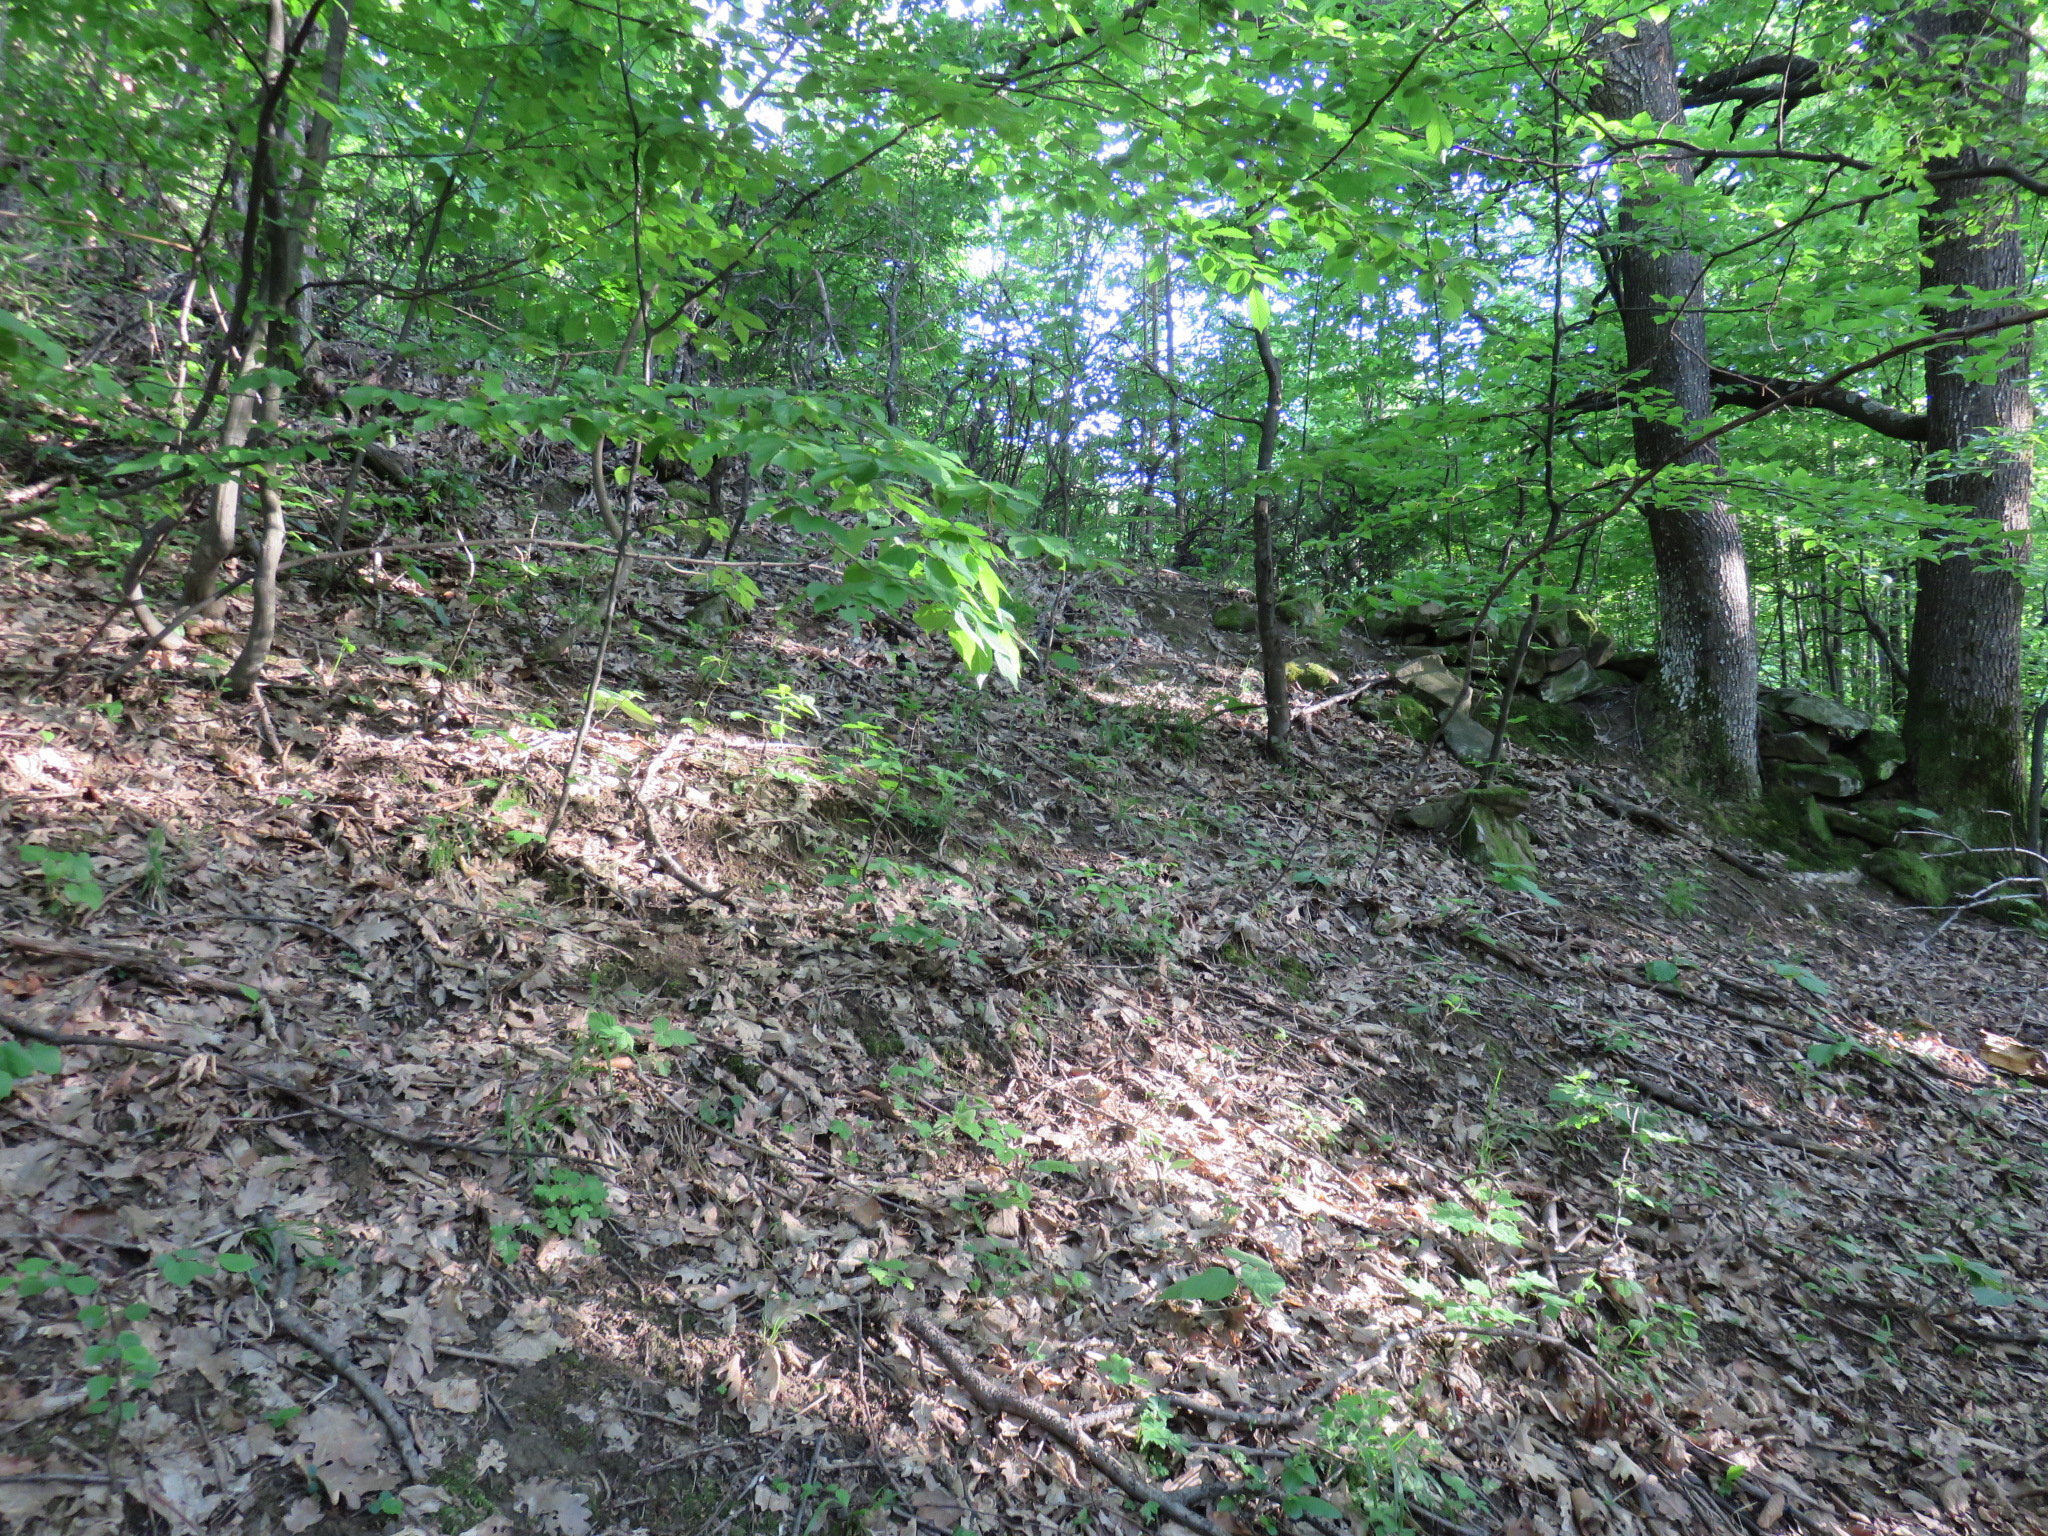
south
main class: Woodland
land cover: Broadleaved woodland
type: mesophytic deciduous forest
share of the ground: > 75 %
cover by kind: broadleaved forest trees 95 %, unconsolidated bare surface 5 %
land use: Forestry
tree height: < 5 m
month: May
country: BG
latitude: 42.8598
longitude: 24.8086
